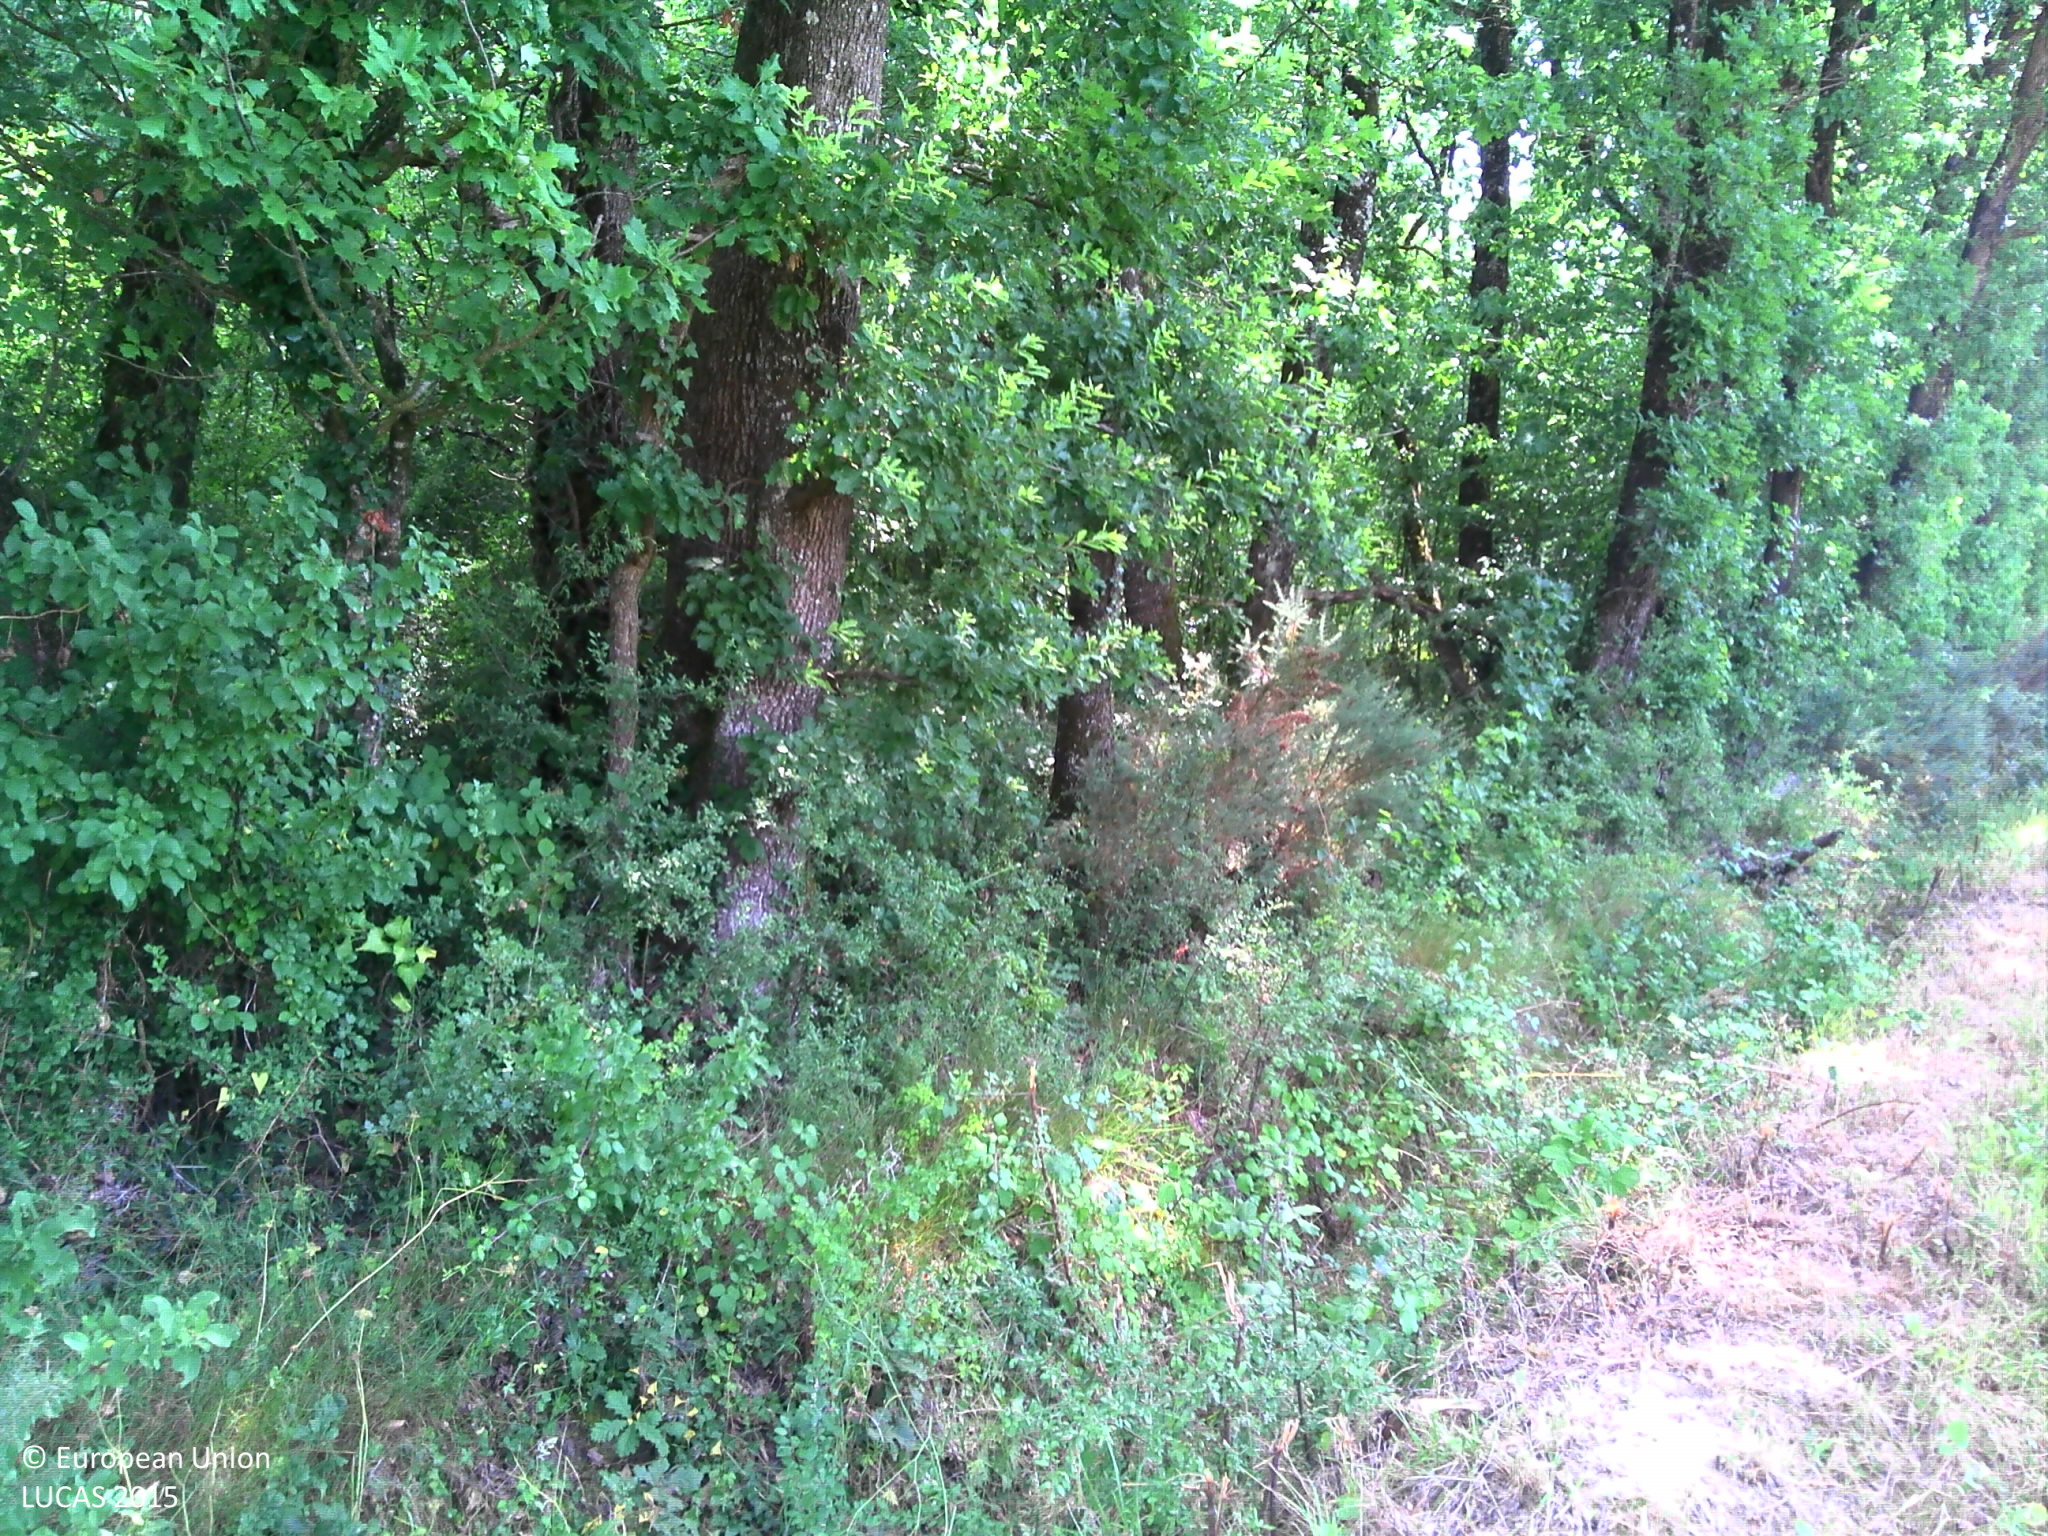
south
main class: Grassland
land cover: Grassland without tree/shrub cover
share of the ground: > 75 %
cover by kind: herbaceous plants 100 %
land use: Agriculture (excluding fallow land and kitchen gardens)
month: July
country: FR
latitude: 44.5079
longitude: 0.8498
